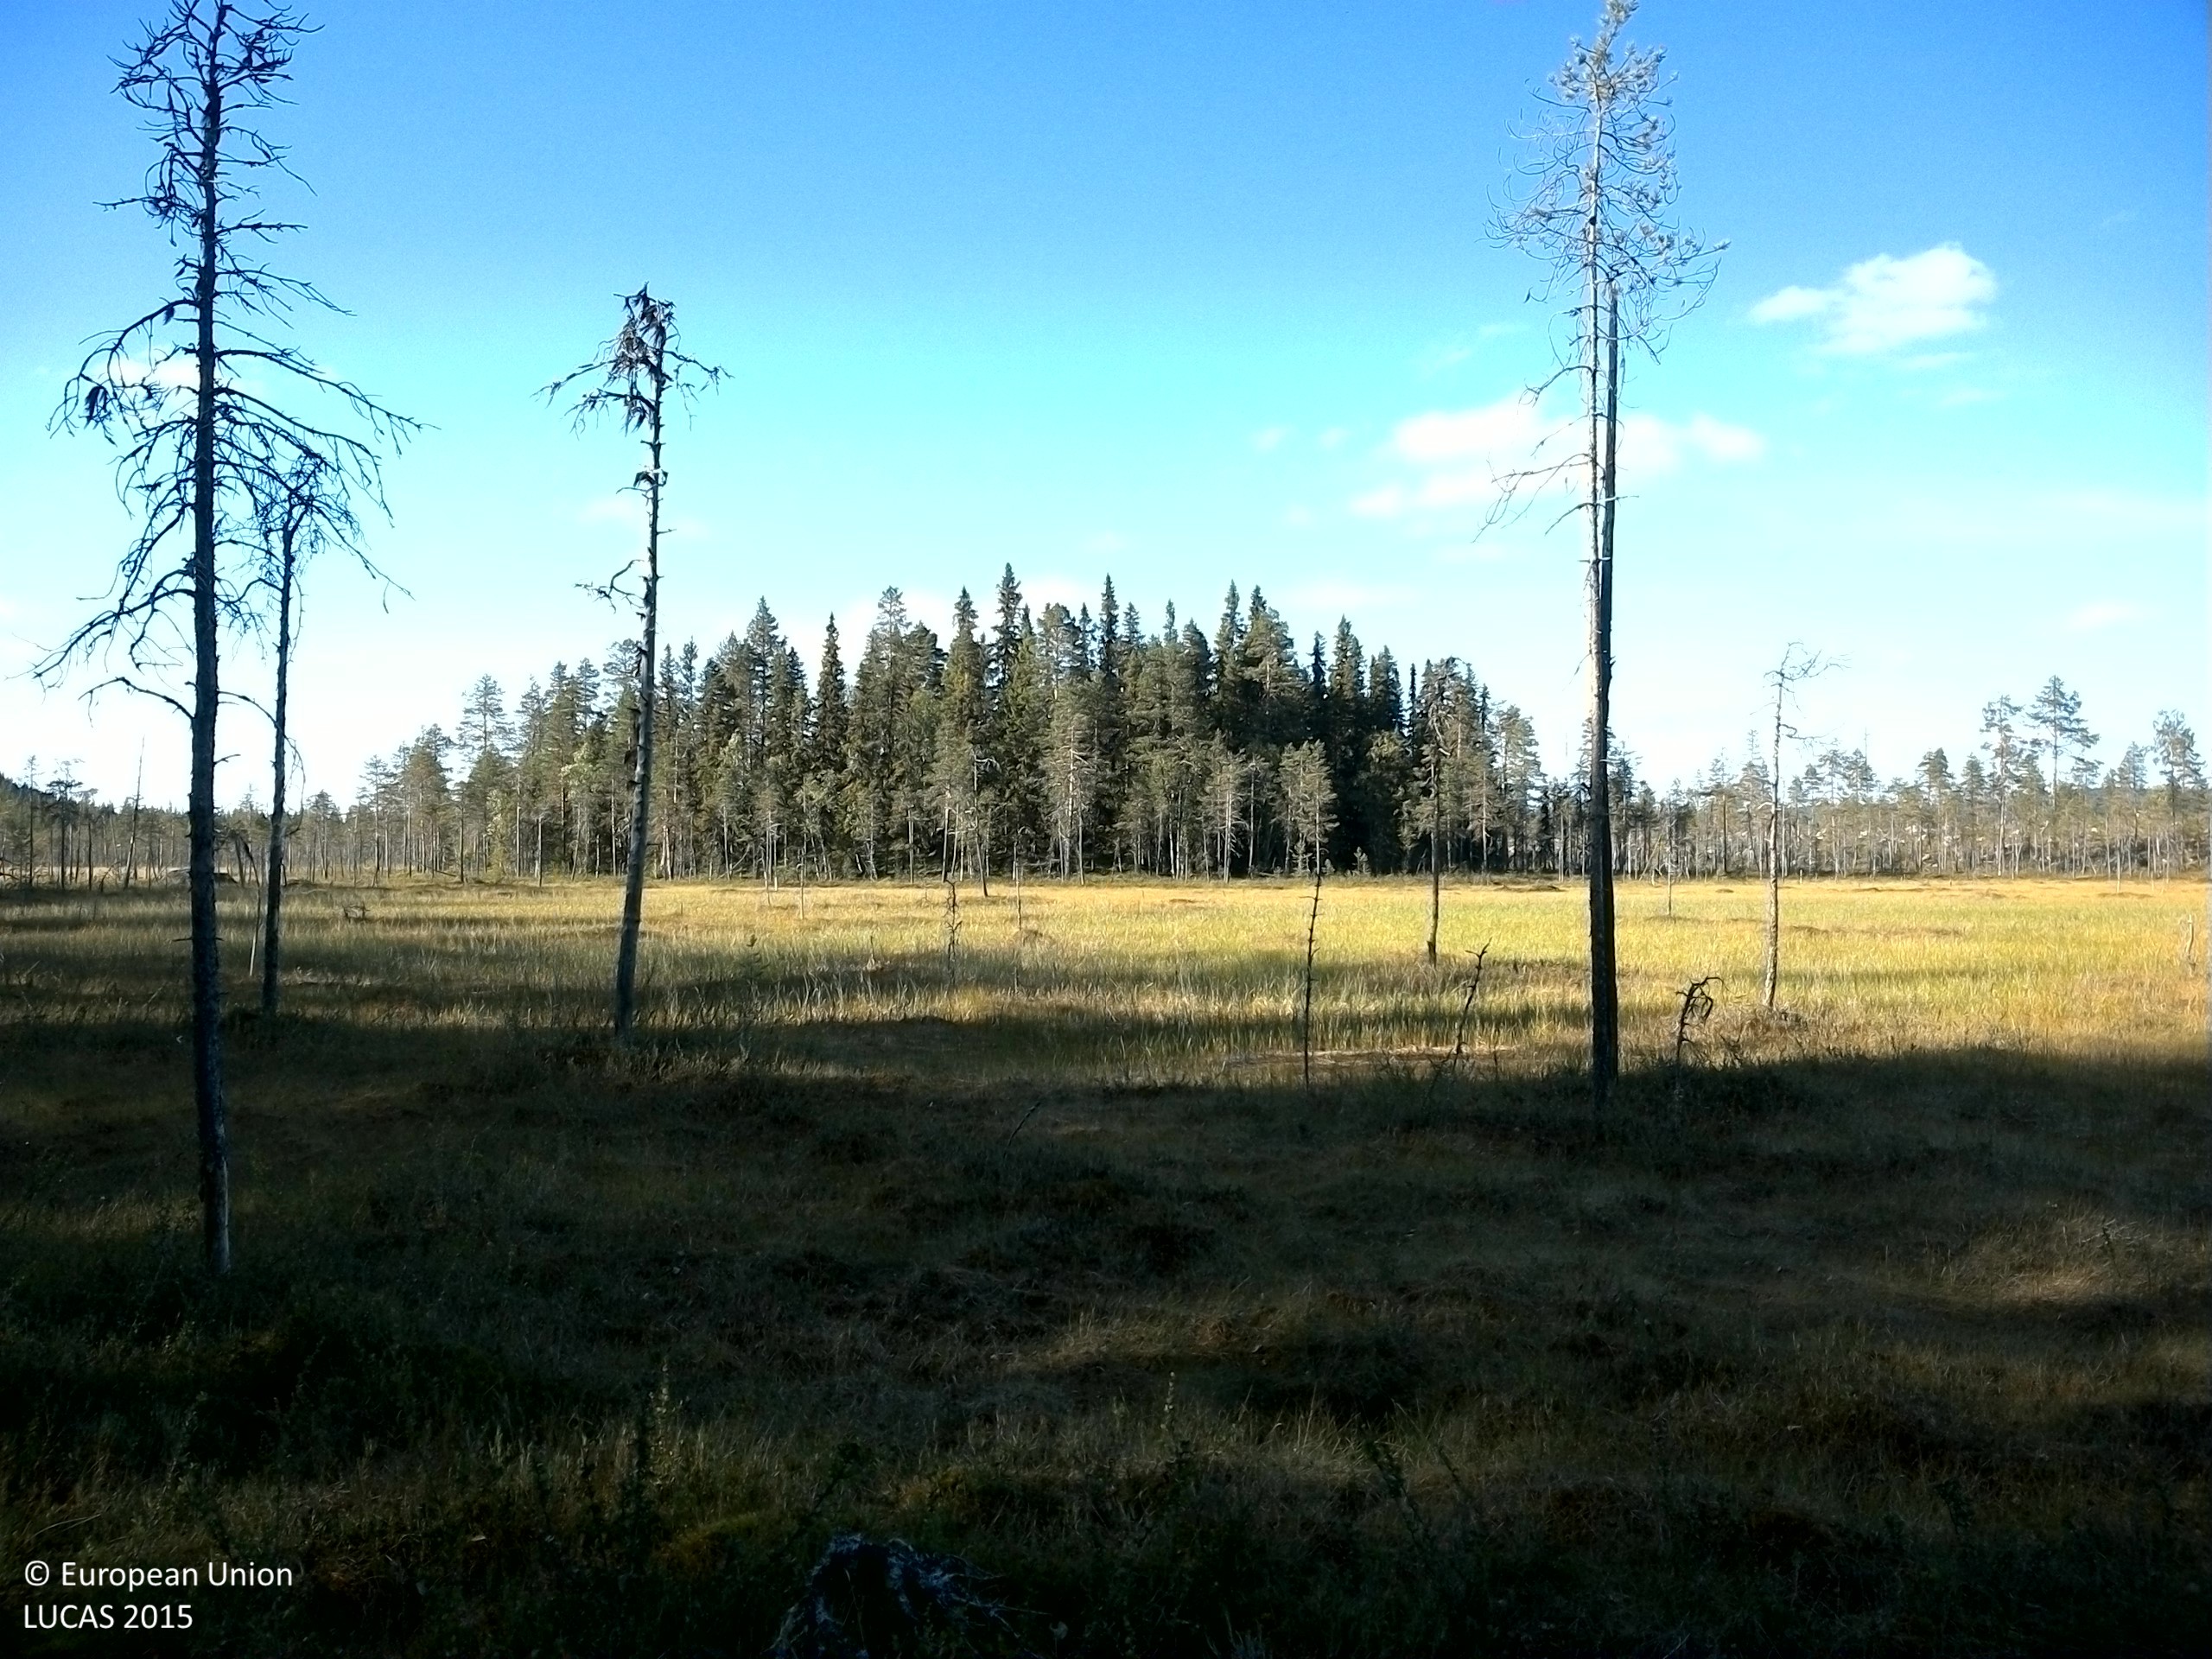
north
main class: Woodland
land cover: Broadleaved woodland
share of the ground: 25 - 50 %
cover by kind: broadleaved forest trees 40 %, herbaceous plants 30 %, lichens and mosses 25 %, shrubs 5 %
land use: Semi-natural and natural areas not in use
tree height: < 5 m
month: August
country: SE
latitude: 64.0918
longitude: 17.5394
